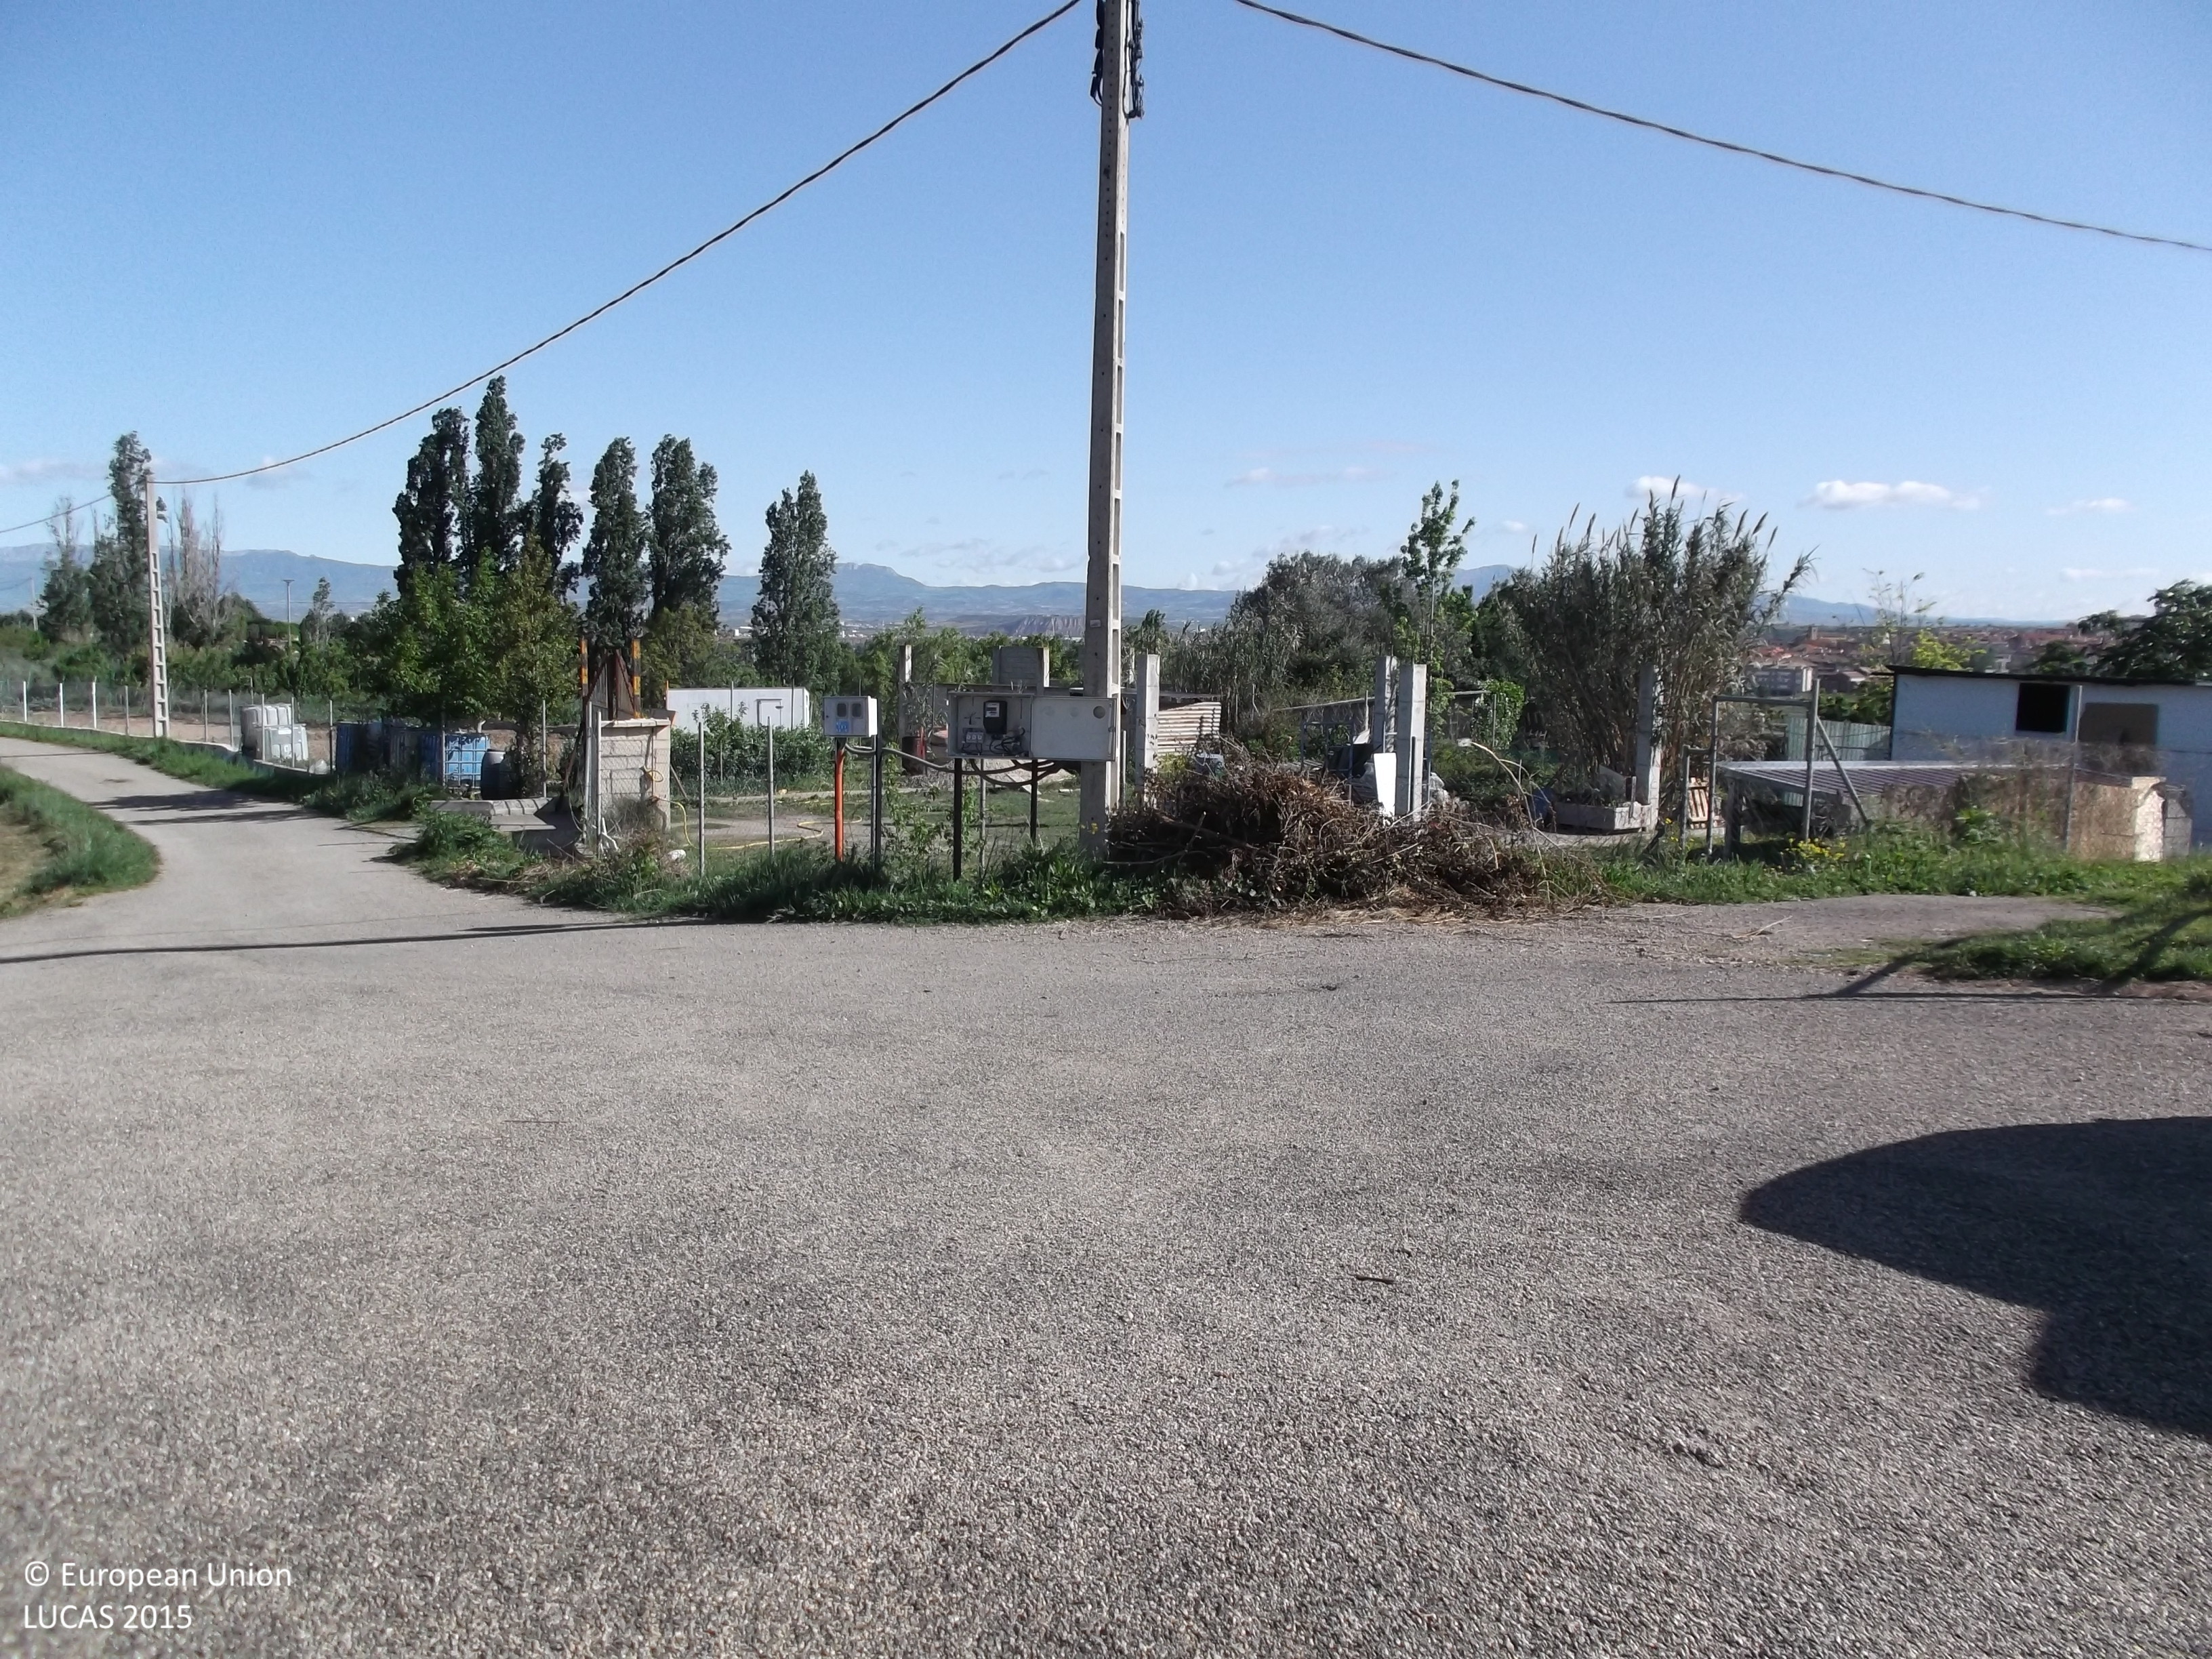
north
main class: Grassland
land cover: Grassland without tree/shrub cover
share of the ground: > 75 %
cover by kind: herbaceous plants 100 %
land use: Residential
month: May
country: ES
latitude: 42.4148
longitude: -2.4270
